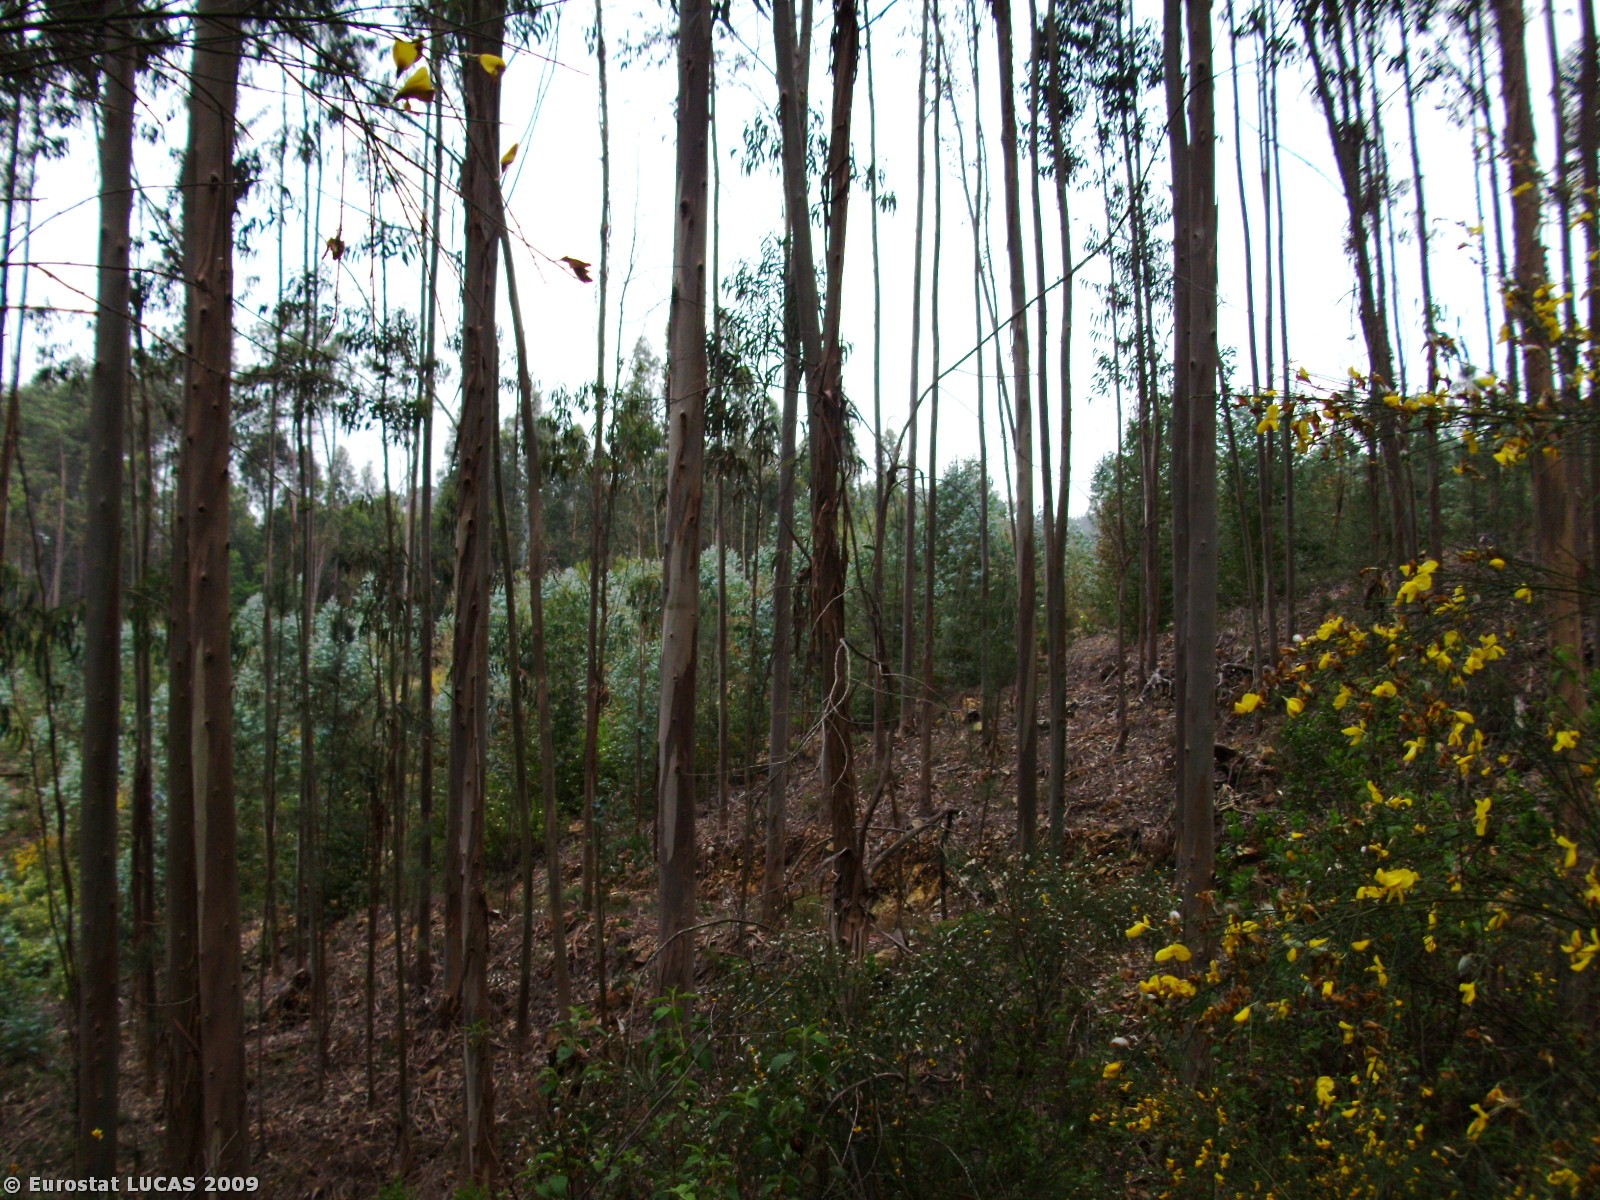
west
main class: Woodland
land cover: Broadleaved woodland
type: plantations and self-sown exotic forest
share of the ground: > 75 %
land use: Forestry
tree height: > 5 m
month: May
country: PT
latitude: 40.4259
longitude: -8.3427
